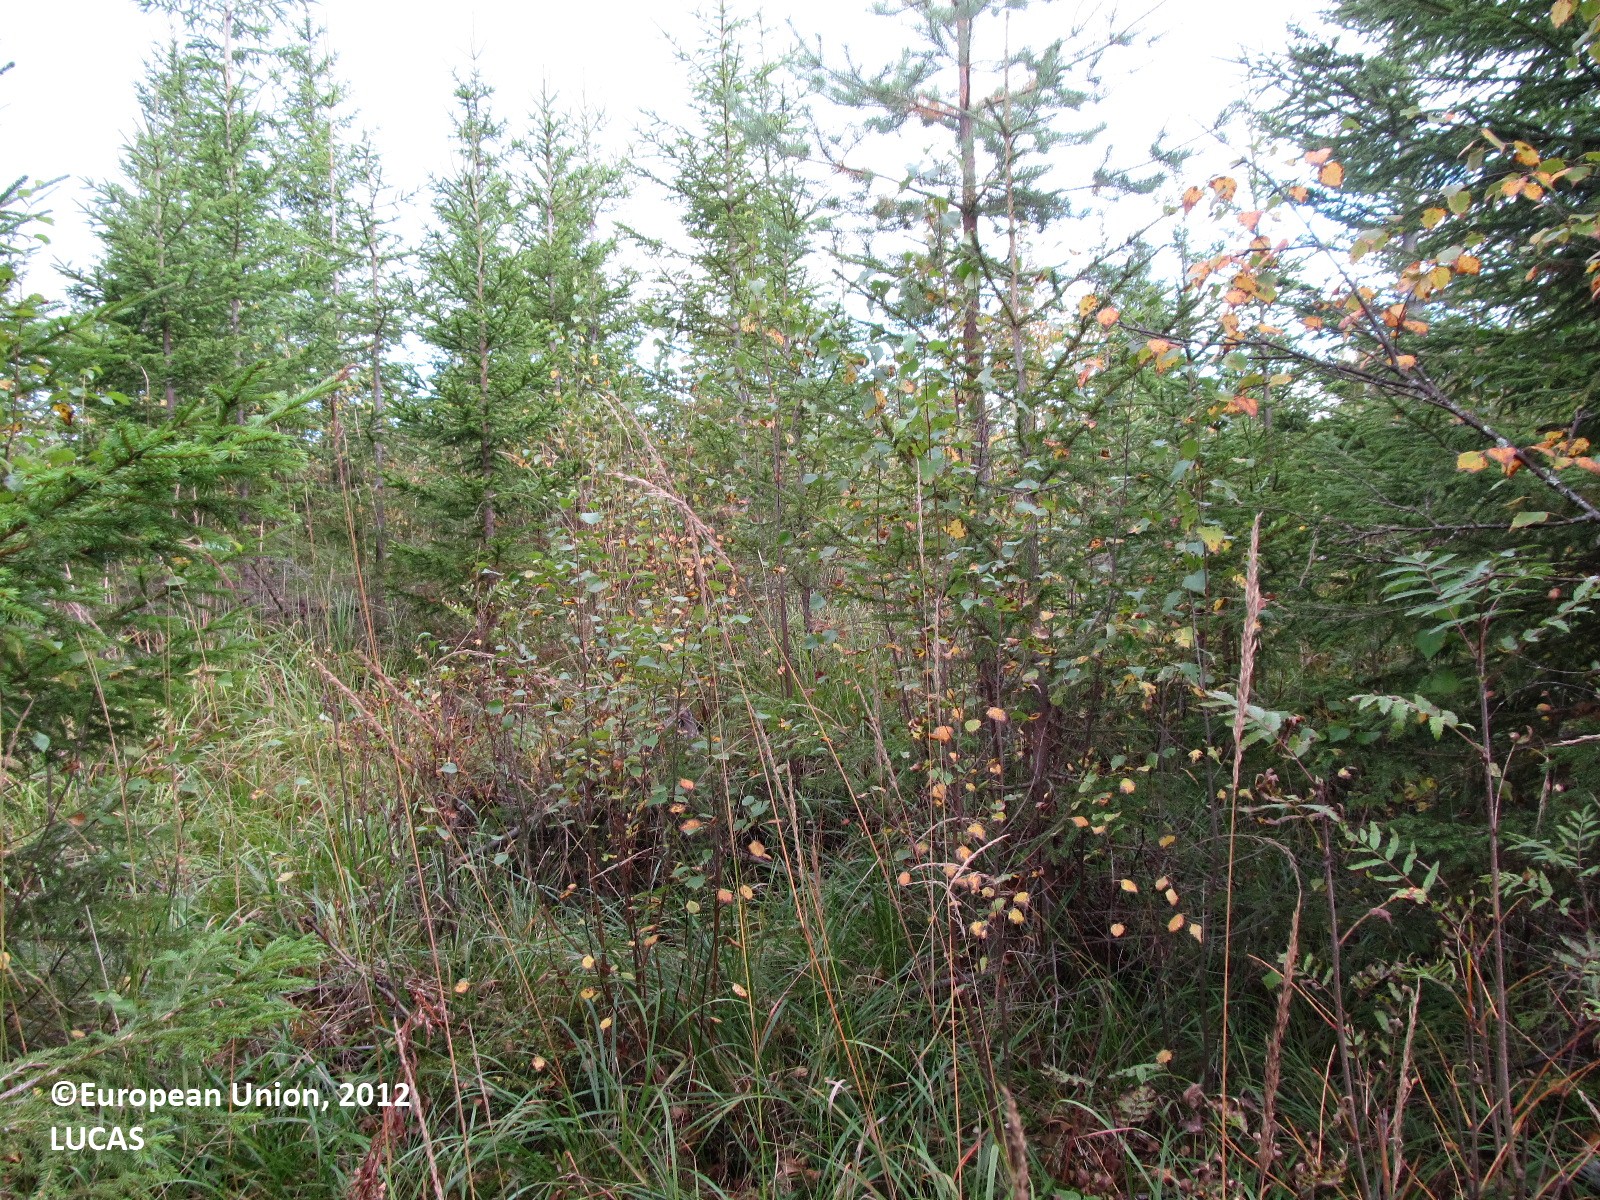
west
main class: Woodland
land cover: Spruce dominated coniferous woodland
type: boreal forest
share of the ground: 50 - 75 %
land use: Forestry
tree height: > 5 m
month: September
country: FI
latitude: 62.6787
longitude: 28.4982
